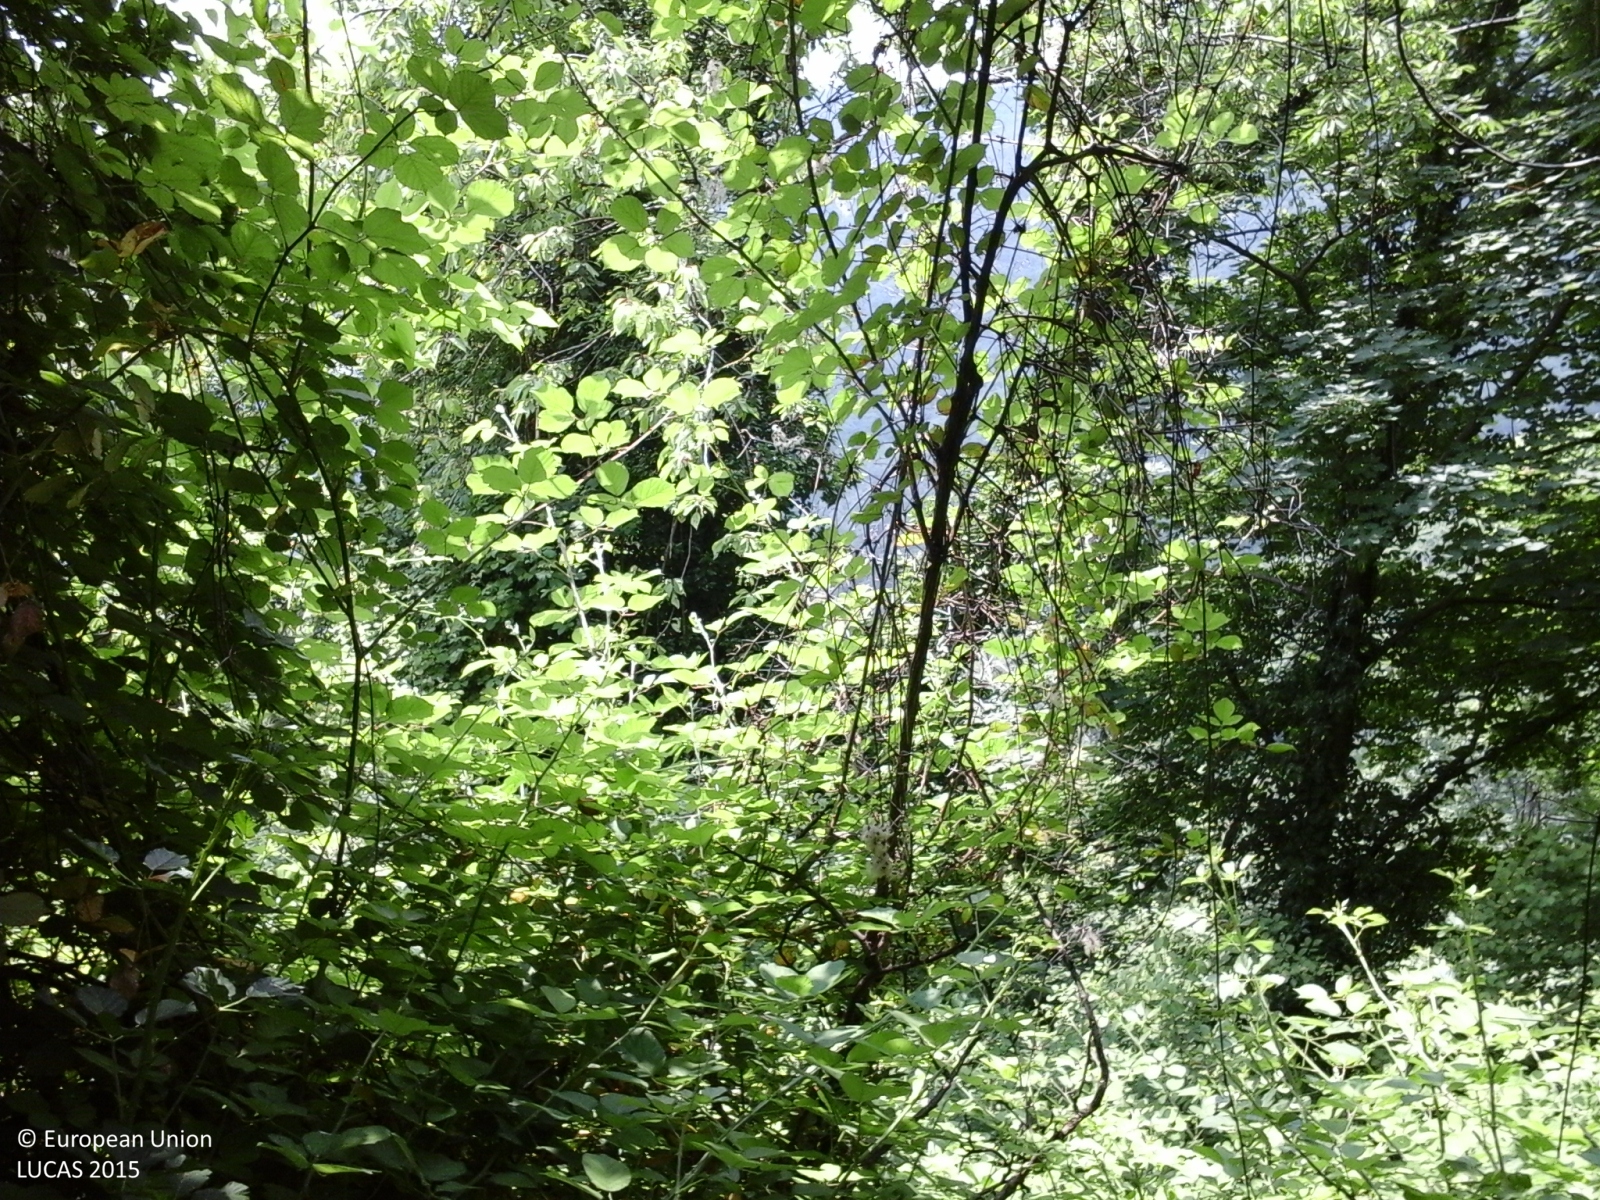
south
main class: Woodland
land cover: Broadleaved woodland
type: thermophilous deciduous forest
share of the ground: > 75 %
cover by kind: broadleaved forest trees 100 %
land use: Semi-natural and natural areas not in use
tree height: > 5 m
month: June
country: IT
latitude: 45.7810
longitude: 11.5796
